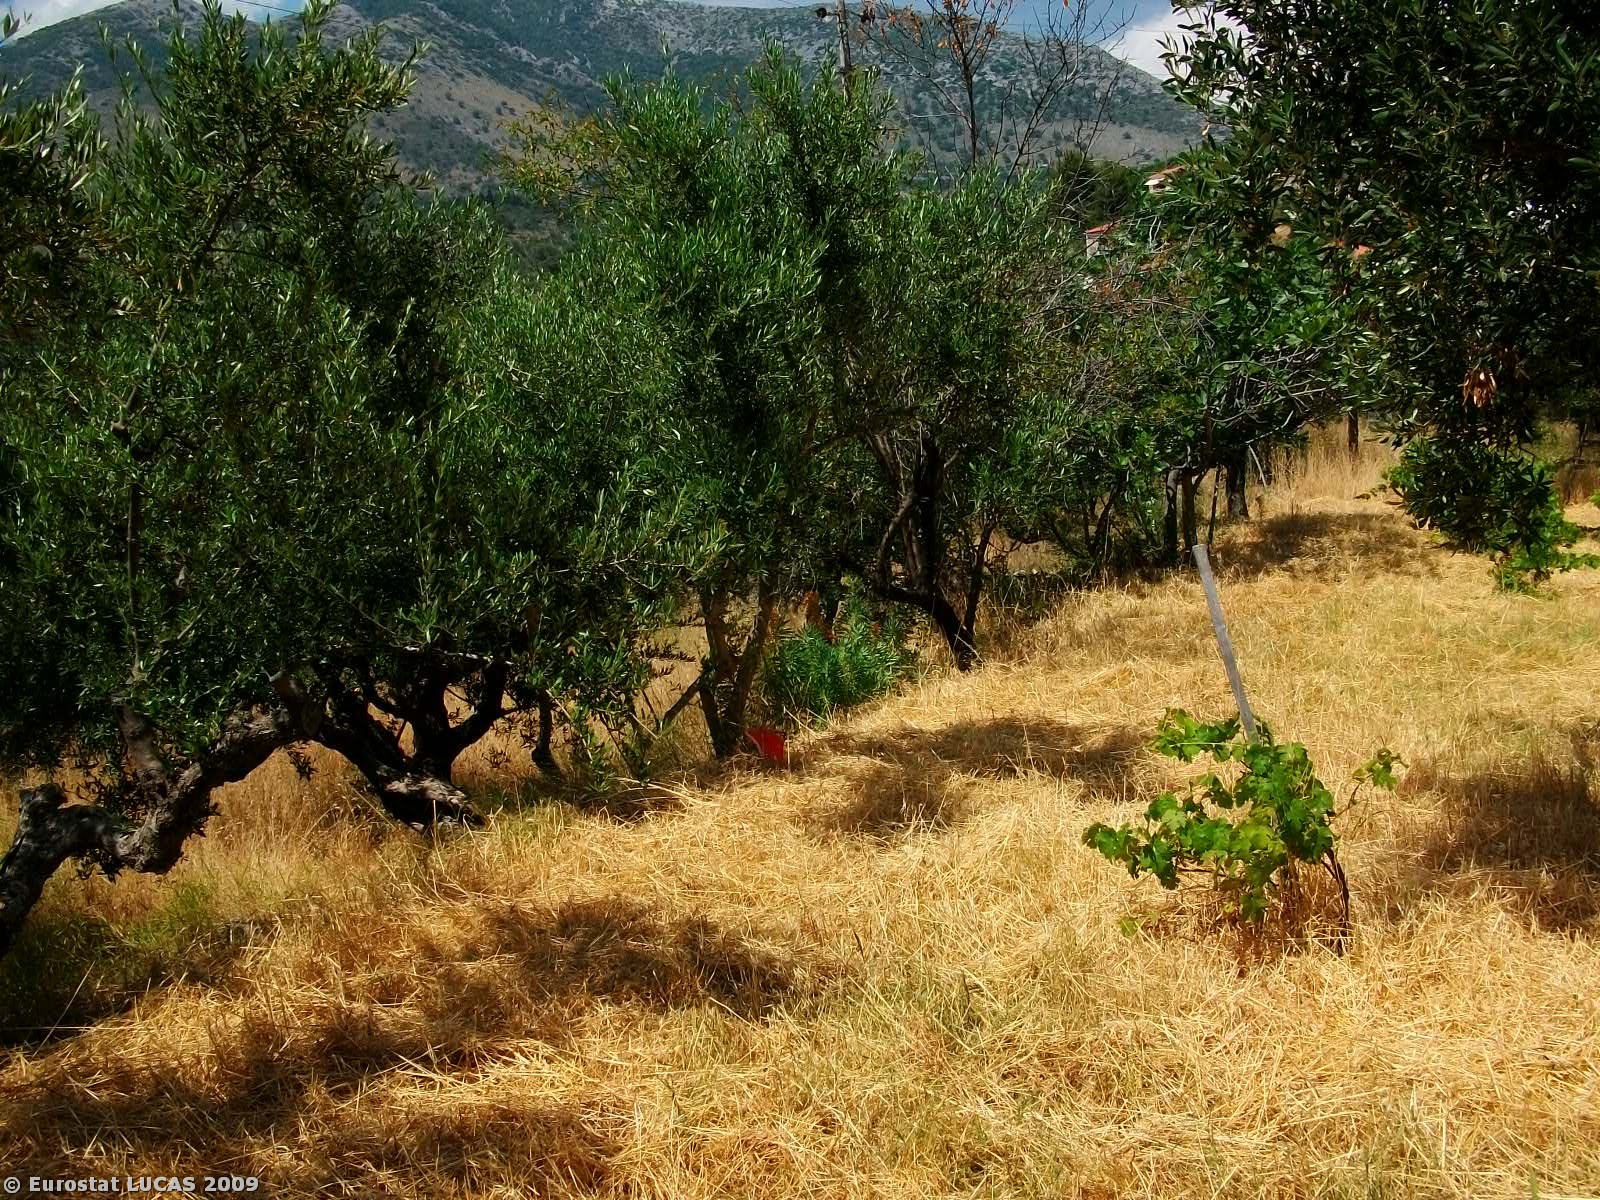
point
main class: Cropland
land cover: Olive groves
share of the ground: 25 - 50 %
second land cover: Vineyards
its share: < 10 %
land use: Agriculture (excluding fallow land and kitchen gardens)
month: June
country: GR
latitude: 36.8332
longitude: 22.3193
